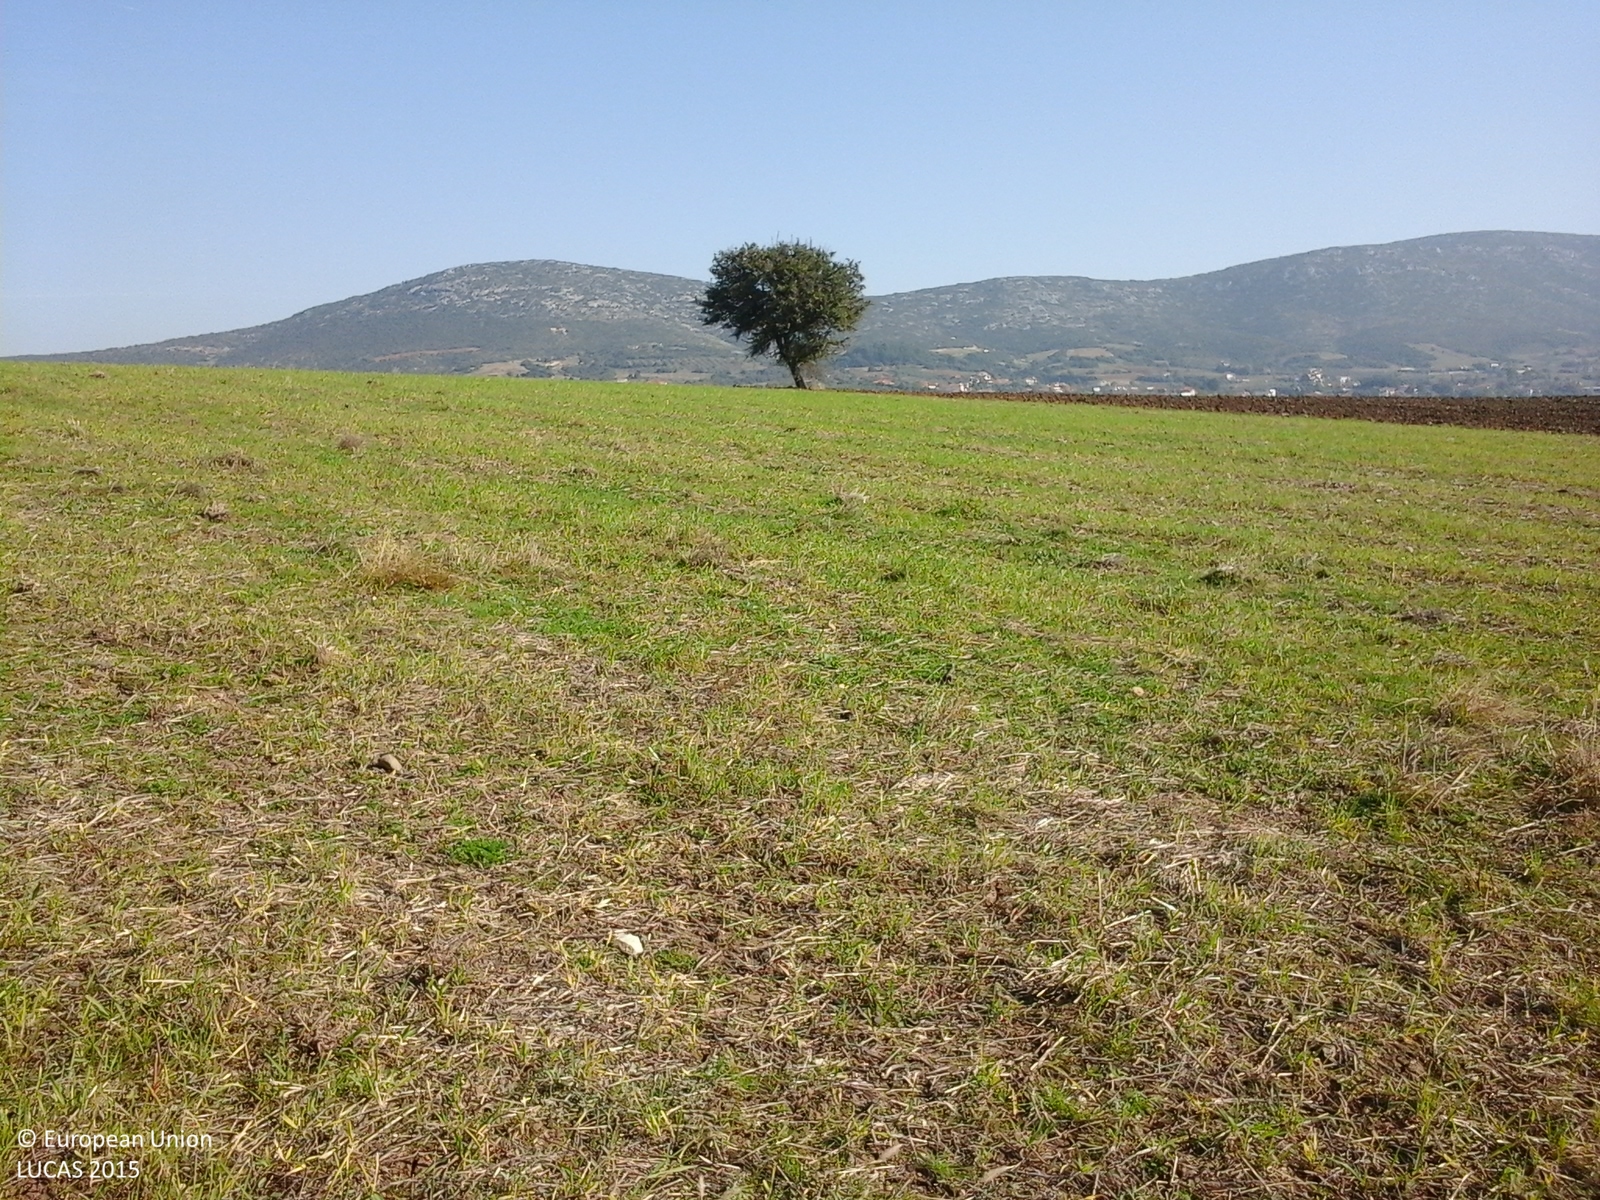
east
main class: Grassland
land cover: Spontaneously vegetated surfaces
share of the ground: > 75 %
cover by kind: herbaceous plants 100 %
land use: Agriculture (excluding fallow land and kitchen gardens)
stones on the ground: < 10 %
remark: Harvested field
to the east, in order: Spontaneously vegetated surfaces; Other bare soil; Spontaneously vegetated surfaces; Shrubland without tree cover
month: November
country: GR
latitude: 40.4036
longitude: 23.1447
